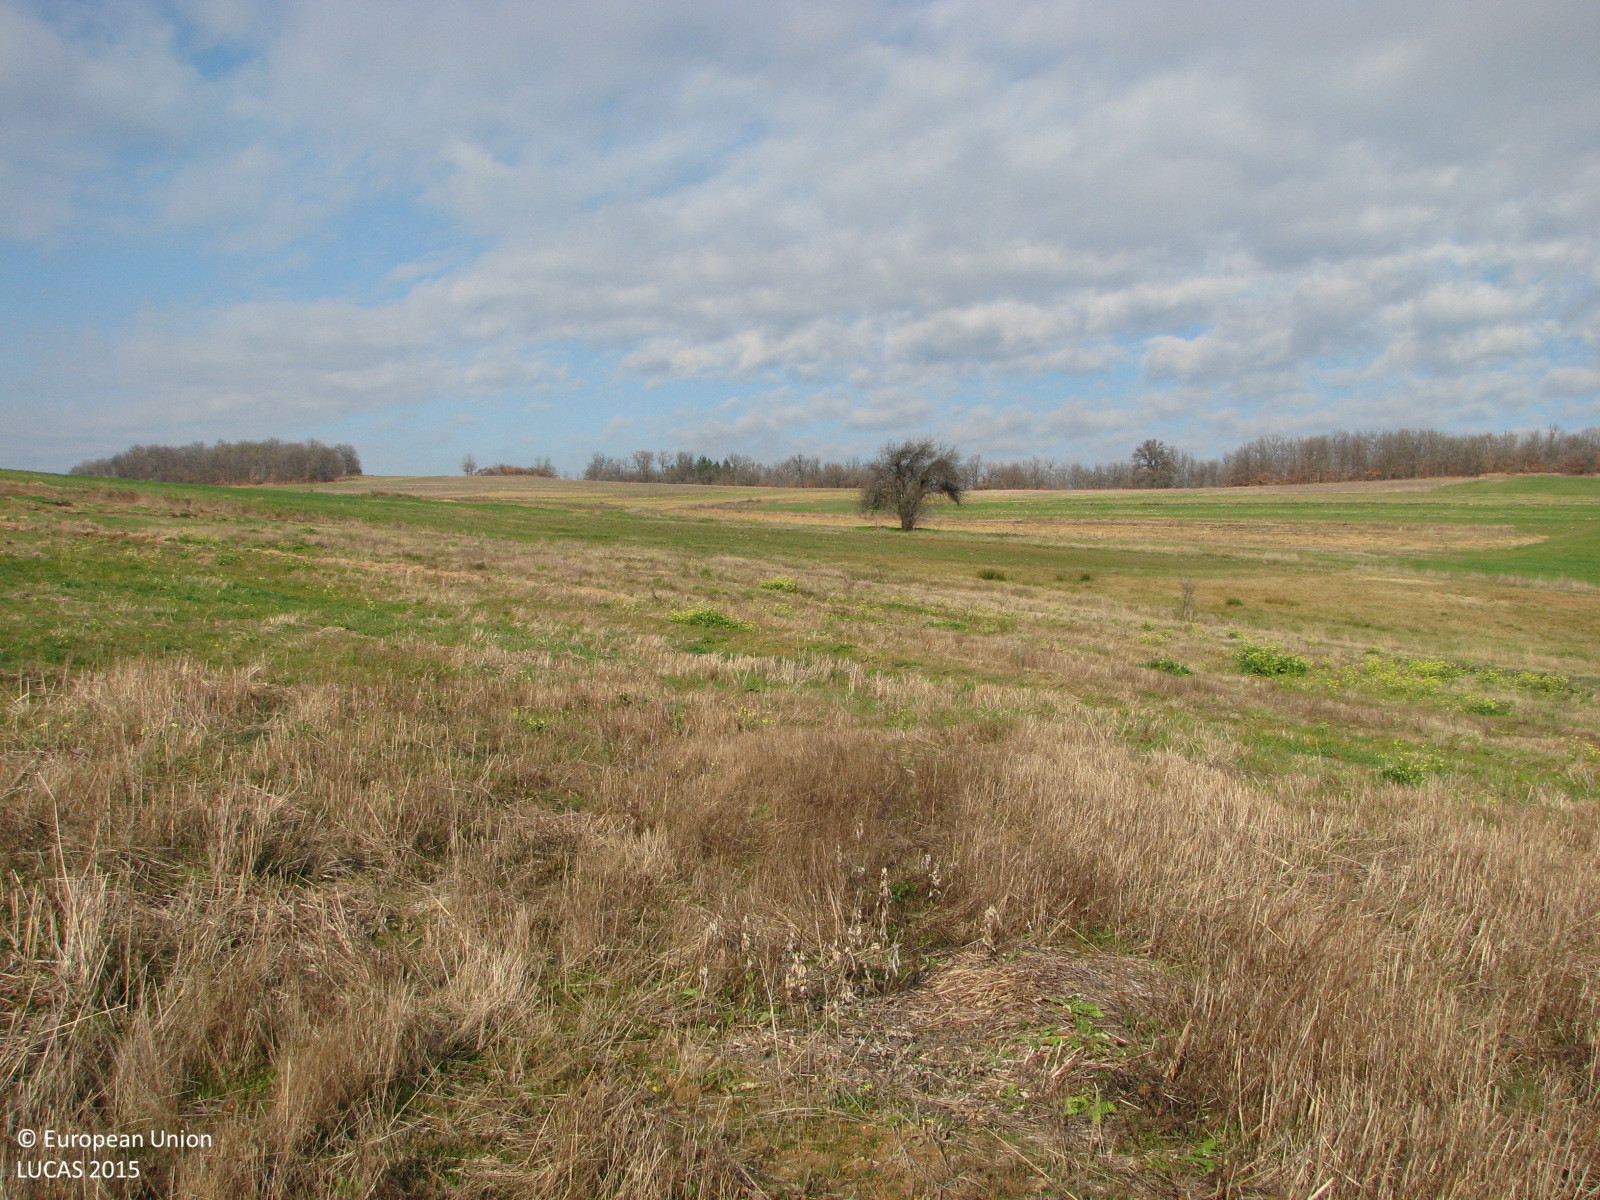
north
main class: Cropland
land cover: Rye
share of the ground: > 75 %
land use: Agriculture (excluding fallow land and kitchen gardens)
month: December
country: BG
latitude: 42.4897
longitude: 24.0717
